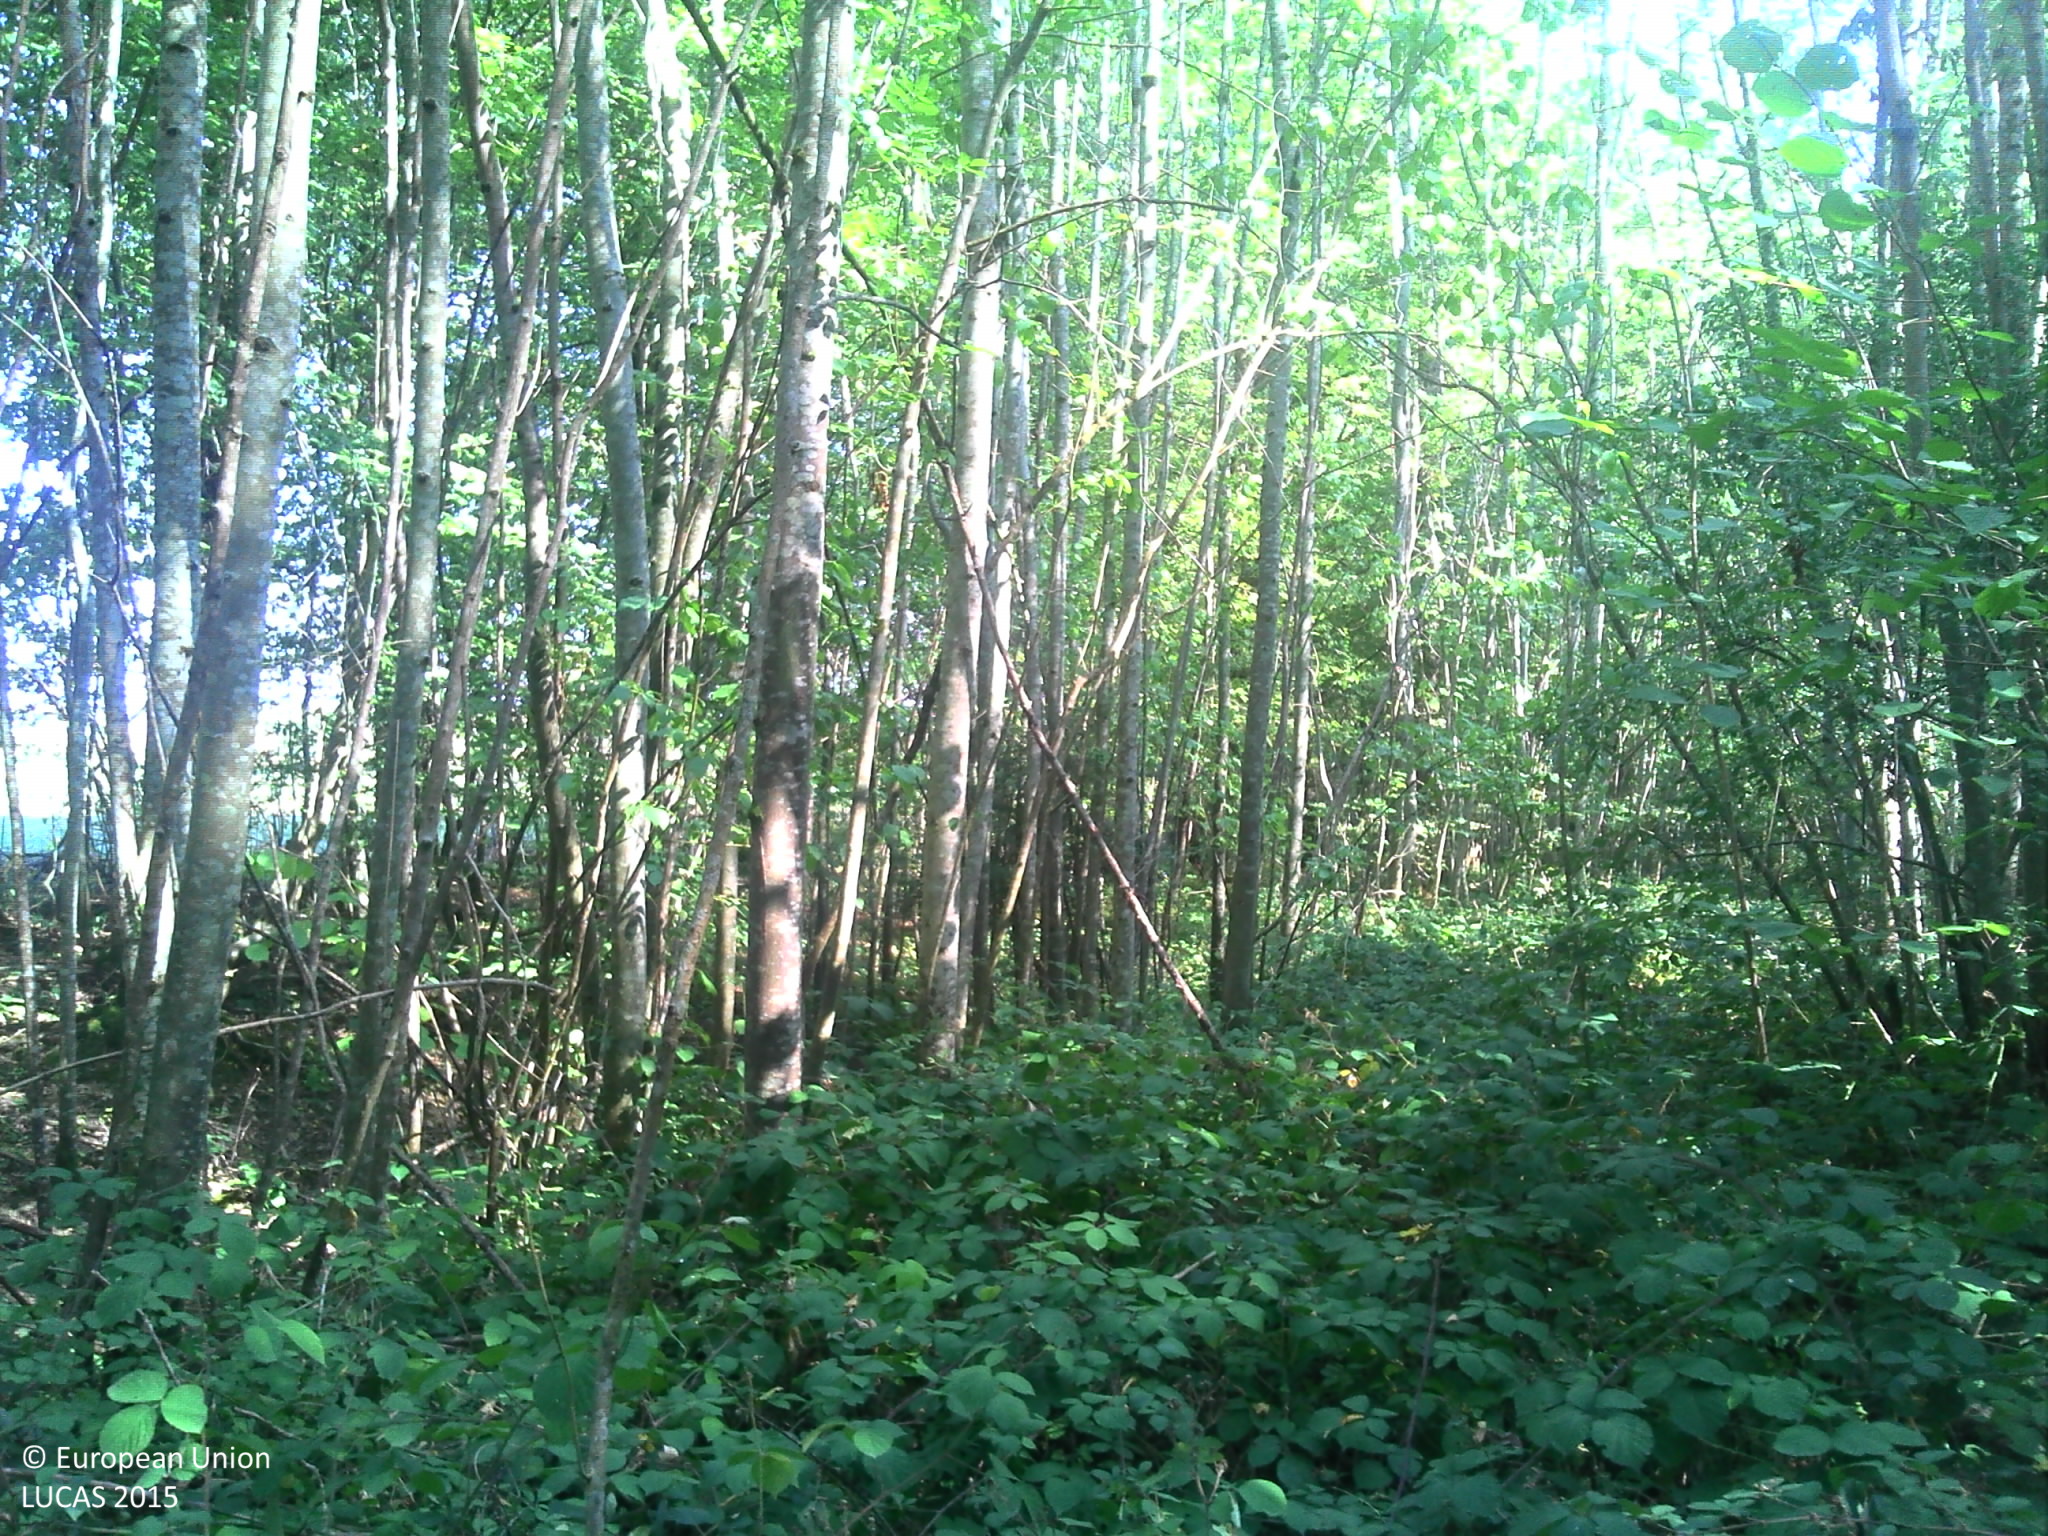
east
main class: Woodland
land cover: Broadleaved woodland
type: mesophytic deciduous forest
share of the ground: > 75 %
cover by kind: broadleaved forest trees 85 %, herbaceous plants 10 %, consolidated bare surface 5 %
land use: Forestry
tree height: > 5 m
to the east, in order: Broadleaved woodland; Temporary grasslands; Fences; Grassland without tree/shrub cover
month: September
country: FR
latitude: 48.8093
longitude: 6.2826
